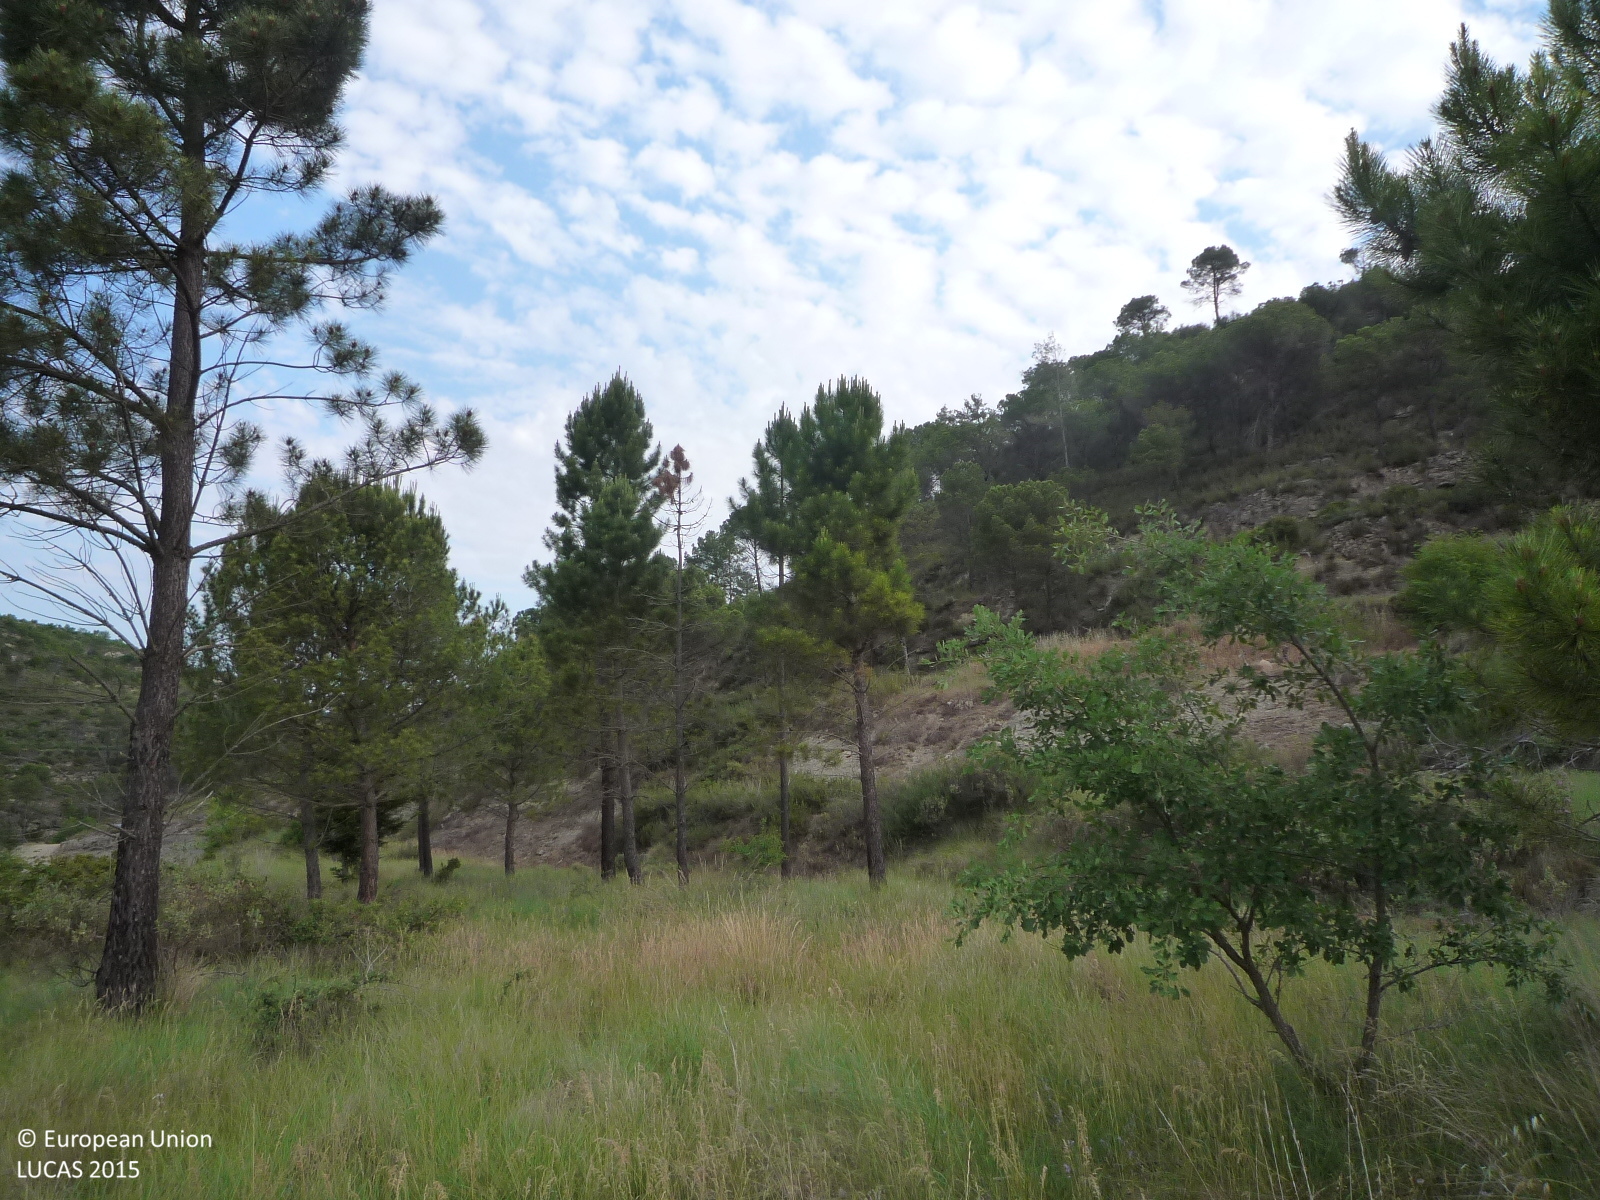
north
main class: Grassland
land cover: Grassland with sparse tree/shrub cover
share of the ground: > 75 %
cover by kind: herbaceous plants 95 %, coniferous forest trees 5 %
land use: Semi-natural and natural areas not in use
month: June
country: ES
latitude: 41.7400
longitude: 2.0196
